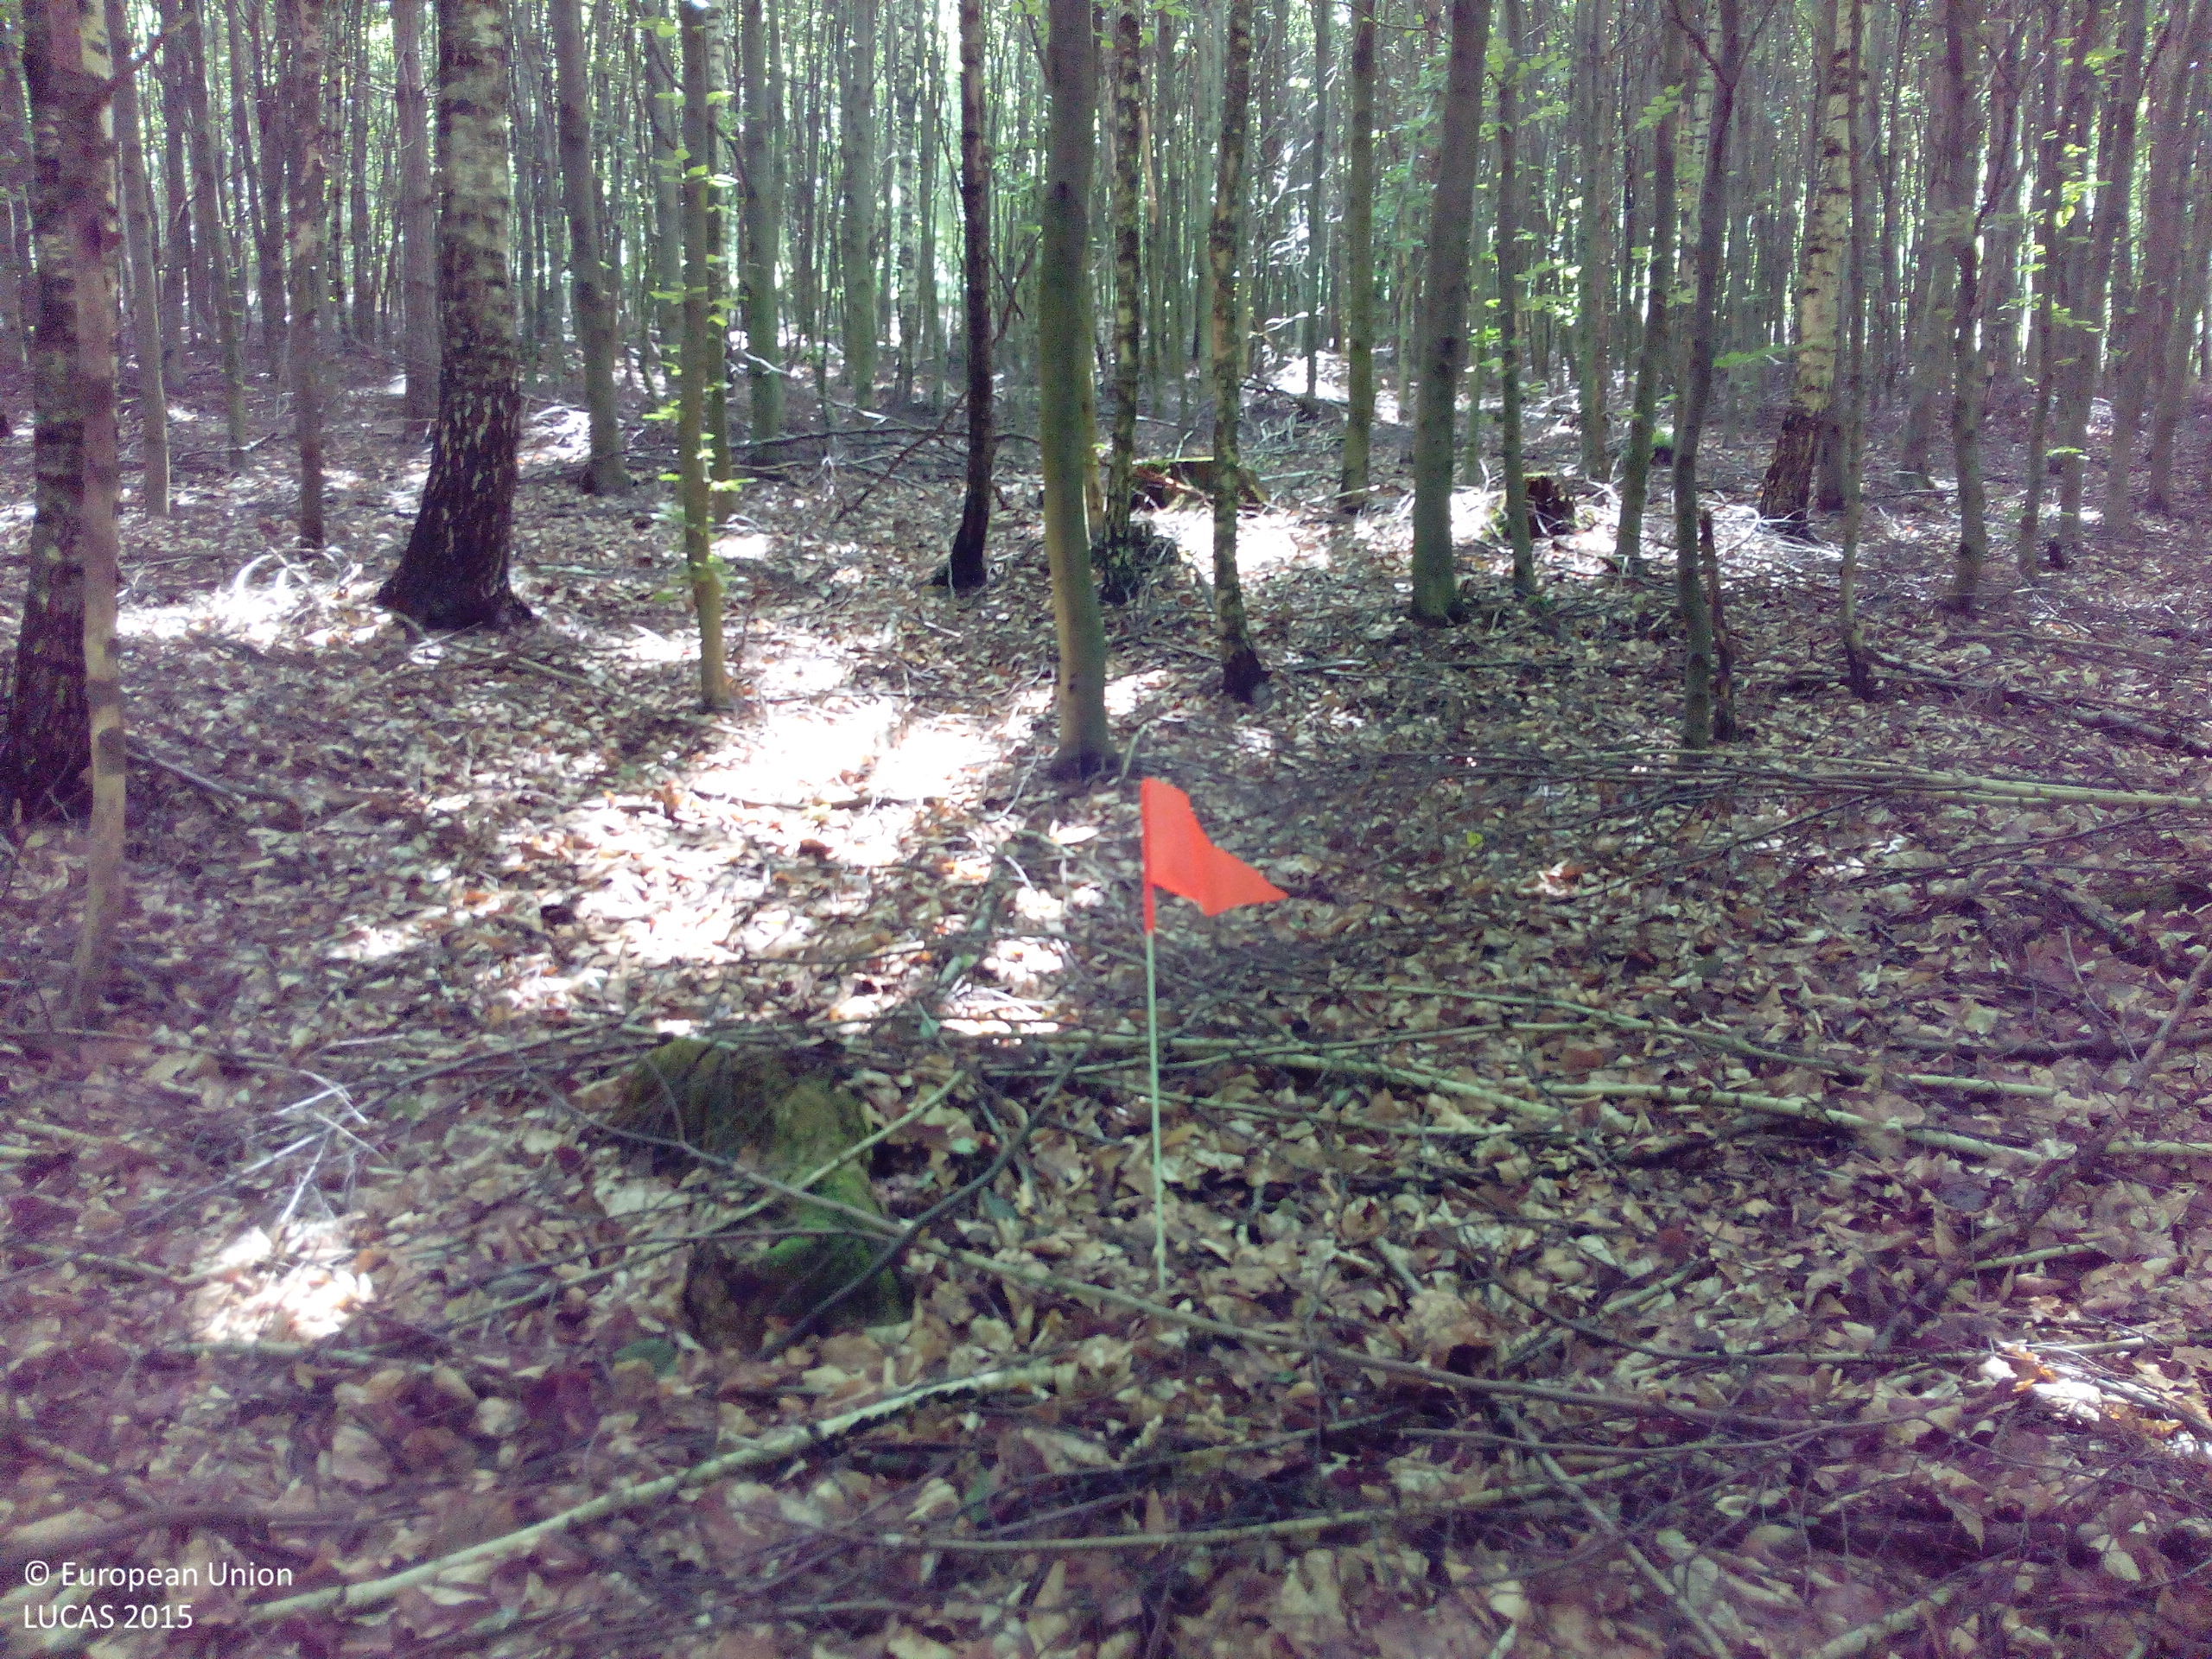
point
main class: Woodland
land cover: Broadleaved woodland
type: beech forest
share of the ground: > 75 %
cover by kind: broadleaved forest trees 90 %, coniferous forest trees 5 %, unconsolidated bare surface 5 %
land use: Forestry
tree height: > 5 m
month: June
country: DE
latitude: 51.0329
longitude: 13.9795
